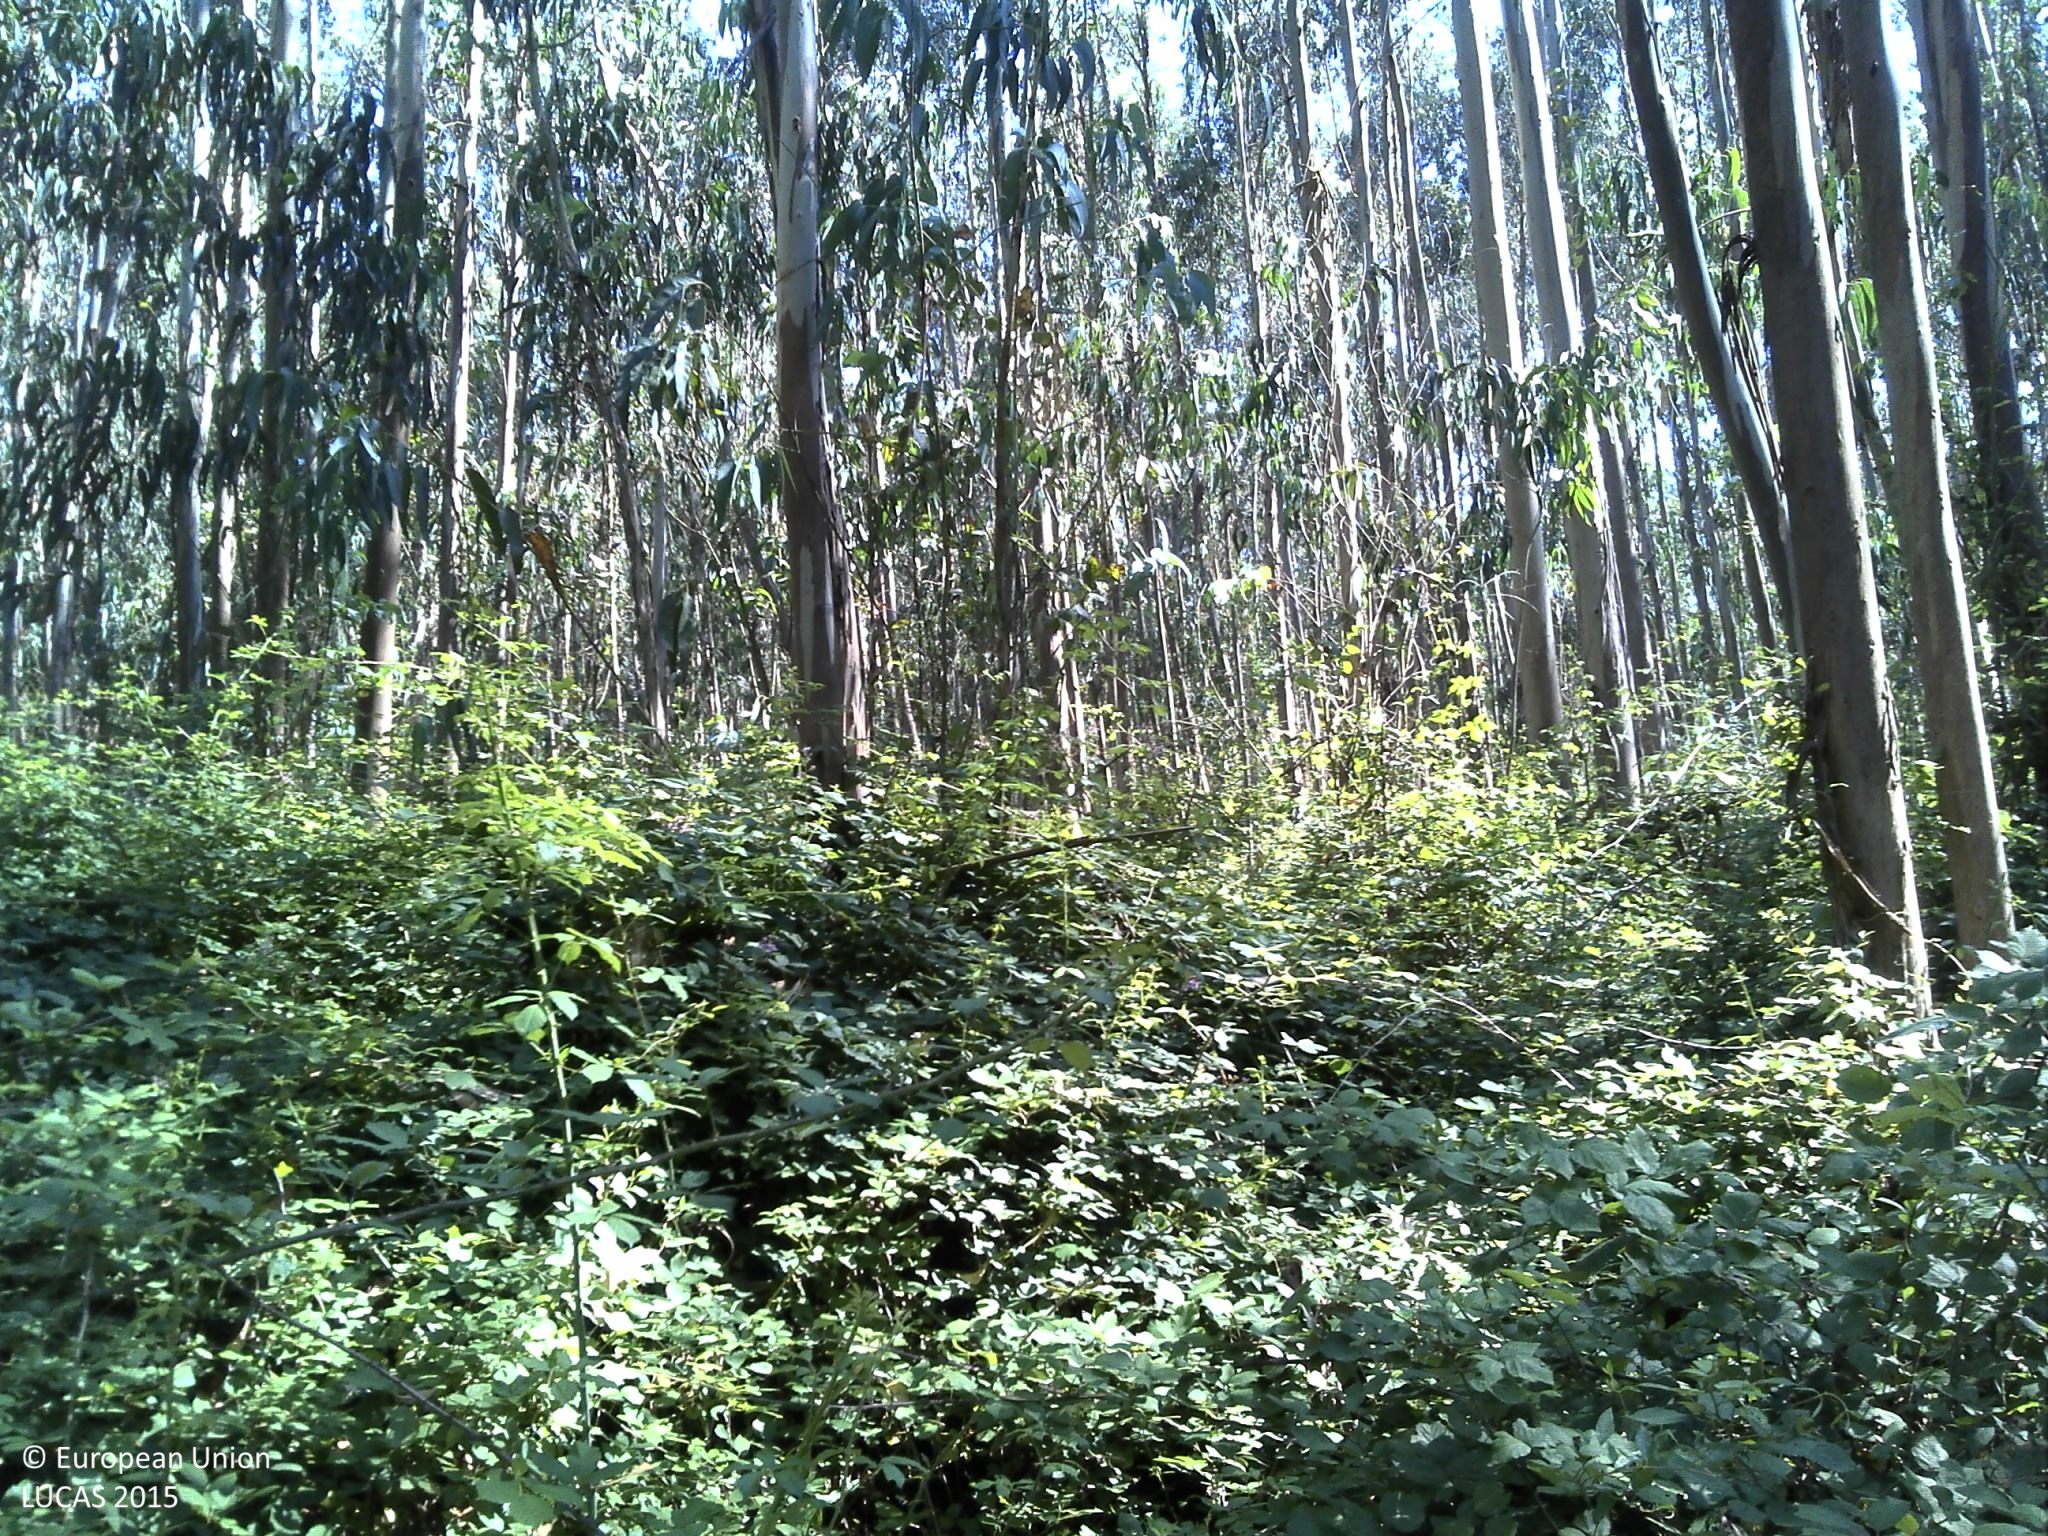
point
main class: Woodland
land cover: Broadleaved woodland
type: exotic forest
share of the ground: > 75 %
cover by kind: broadleaved forest trees 80 %, shrubs 10 %, unconsolidated bare surface 10 %
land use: Forestry
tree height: > 5 m
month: June
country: PT
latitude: 39.2107
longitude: -9.2553
